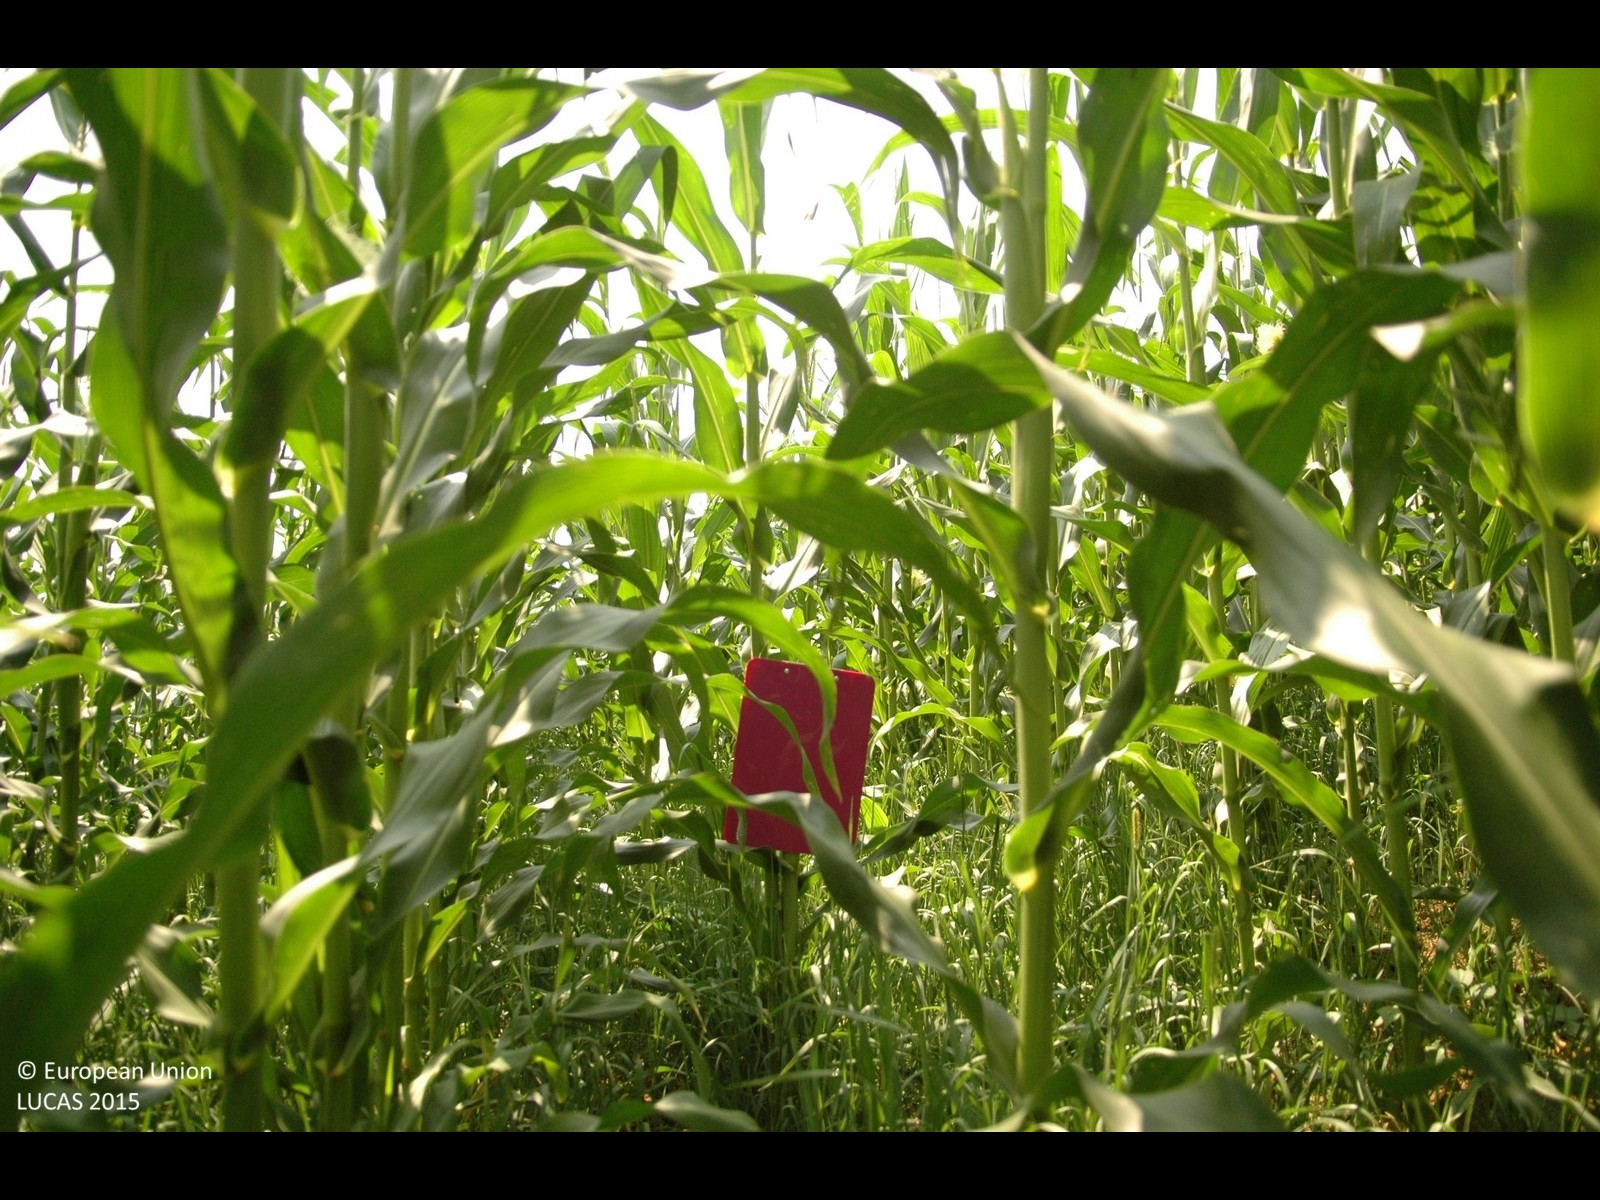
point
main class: Cropland
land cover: Maize
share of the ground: > 75 %
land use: Agriculture (excluding fallow land and kitchen gardens)
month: July
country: HR
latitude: 46.1412
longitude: 16.0963
